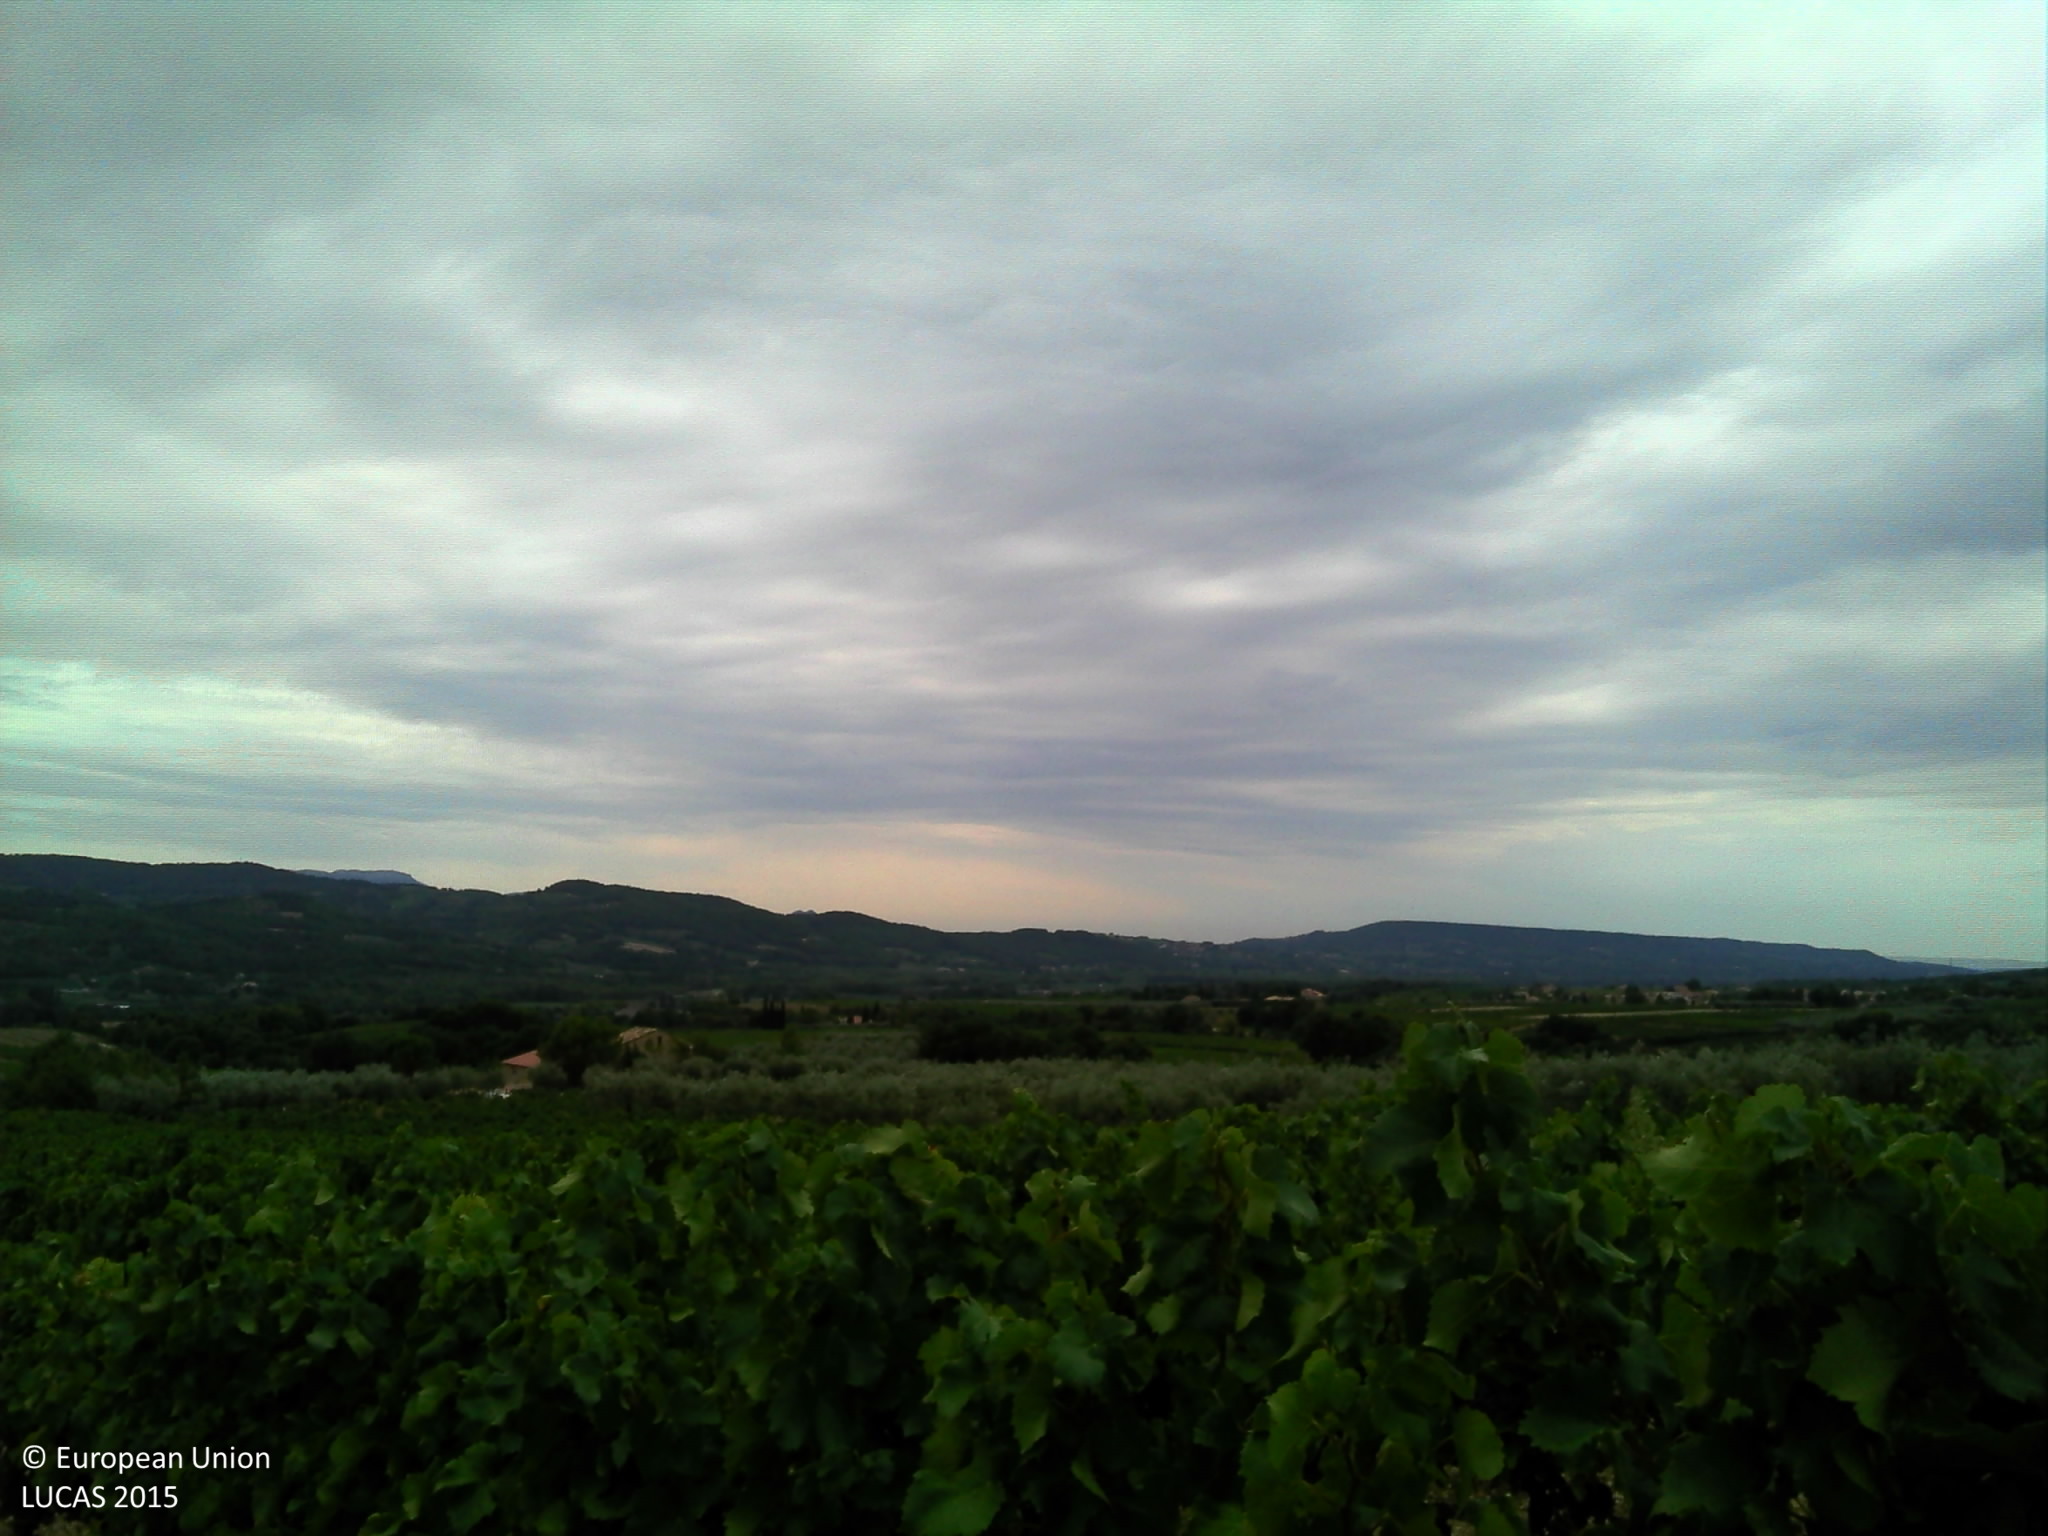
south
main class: Cropland
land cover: Vineyards
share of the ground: 50 - 75 %
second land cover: Grassland without tree/shrub cover
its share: 10 - 25 %
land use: Agriculture (excluding fallow land and kitchen gardens)
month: September
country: FR
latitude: 44.3422
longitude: 5.0780
